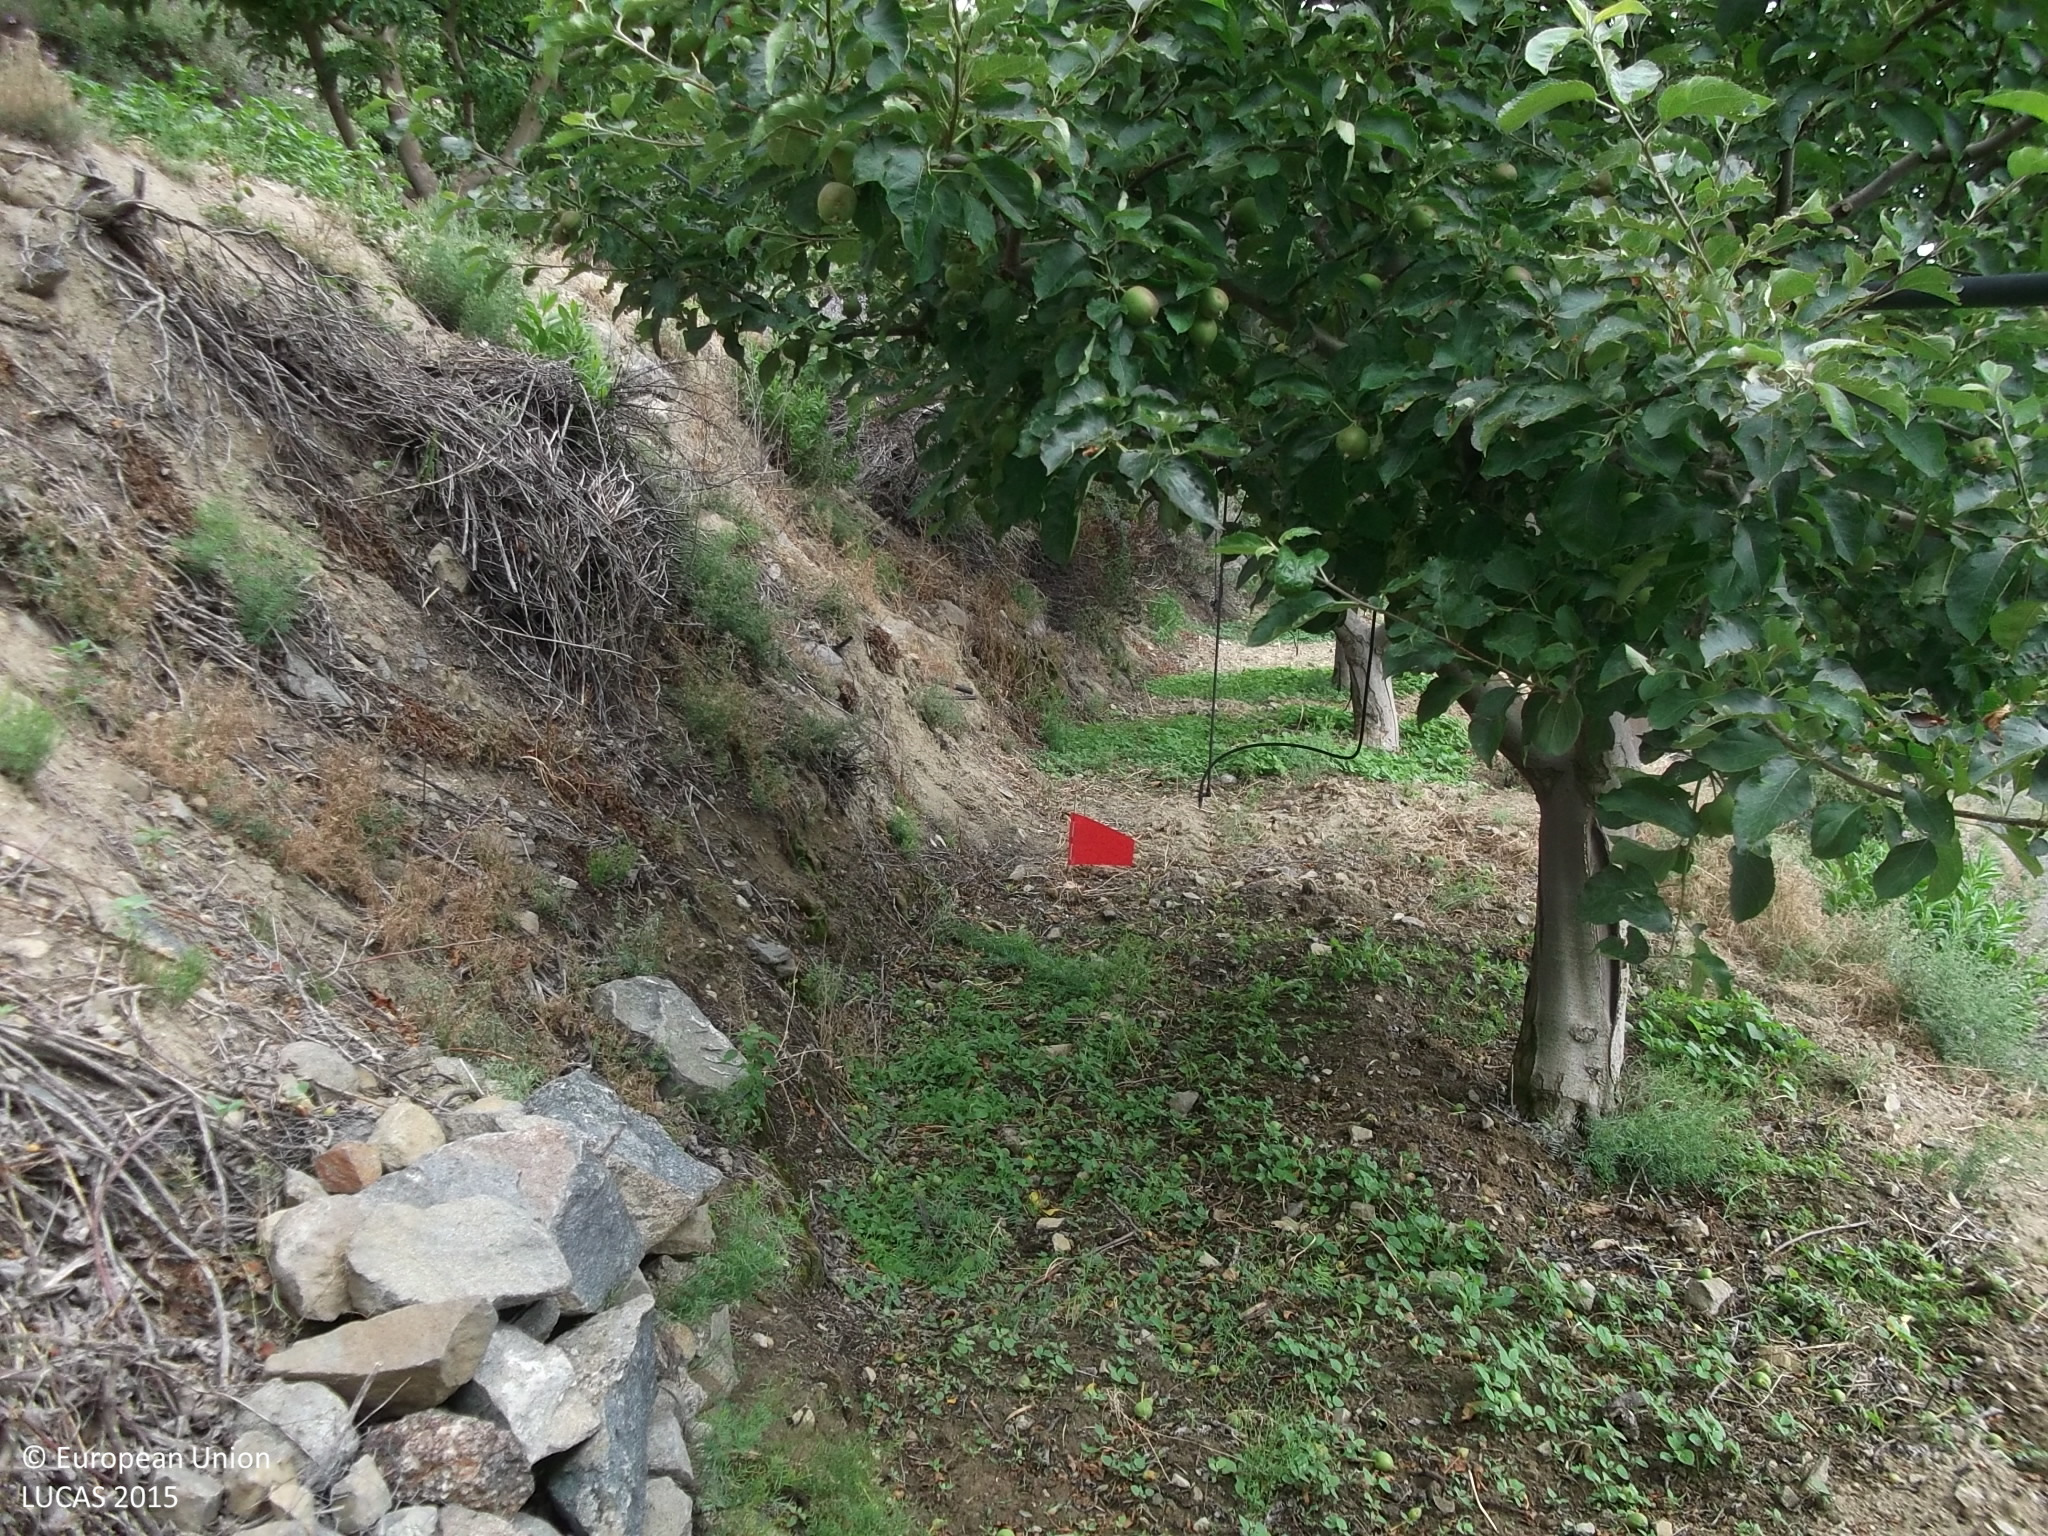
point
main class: Cropland
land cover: Apple fruit
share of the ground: > 75 %
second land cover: Grassland without tree/shrub cover
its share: 25 - 50 %
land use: Agriculture (excluding fallow land and kitchen gardens)
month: June
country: CY
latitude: 34.9371
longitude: 32.9535
